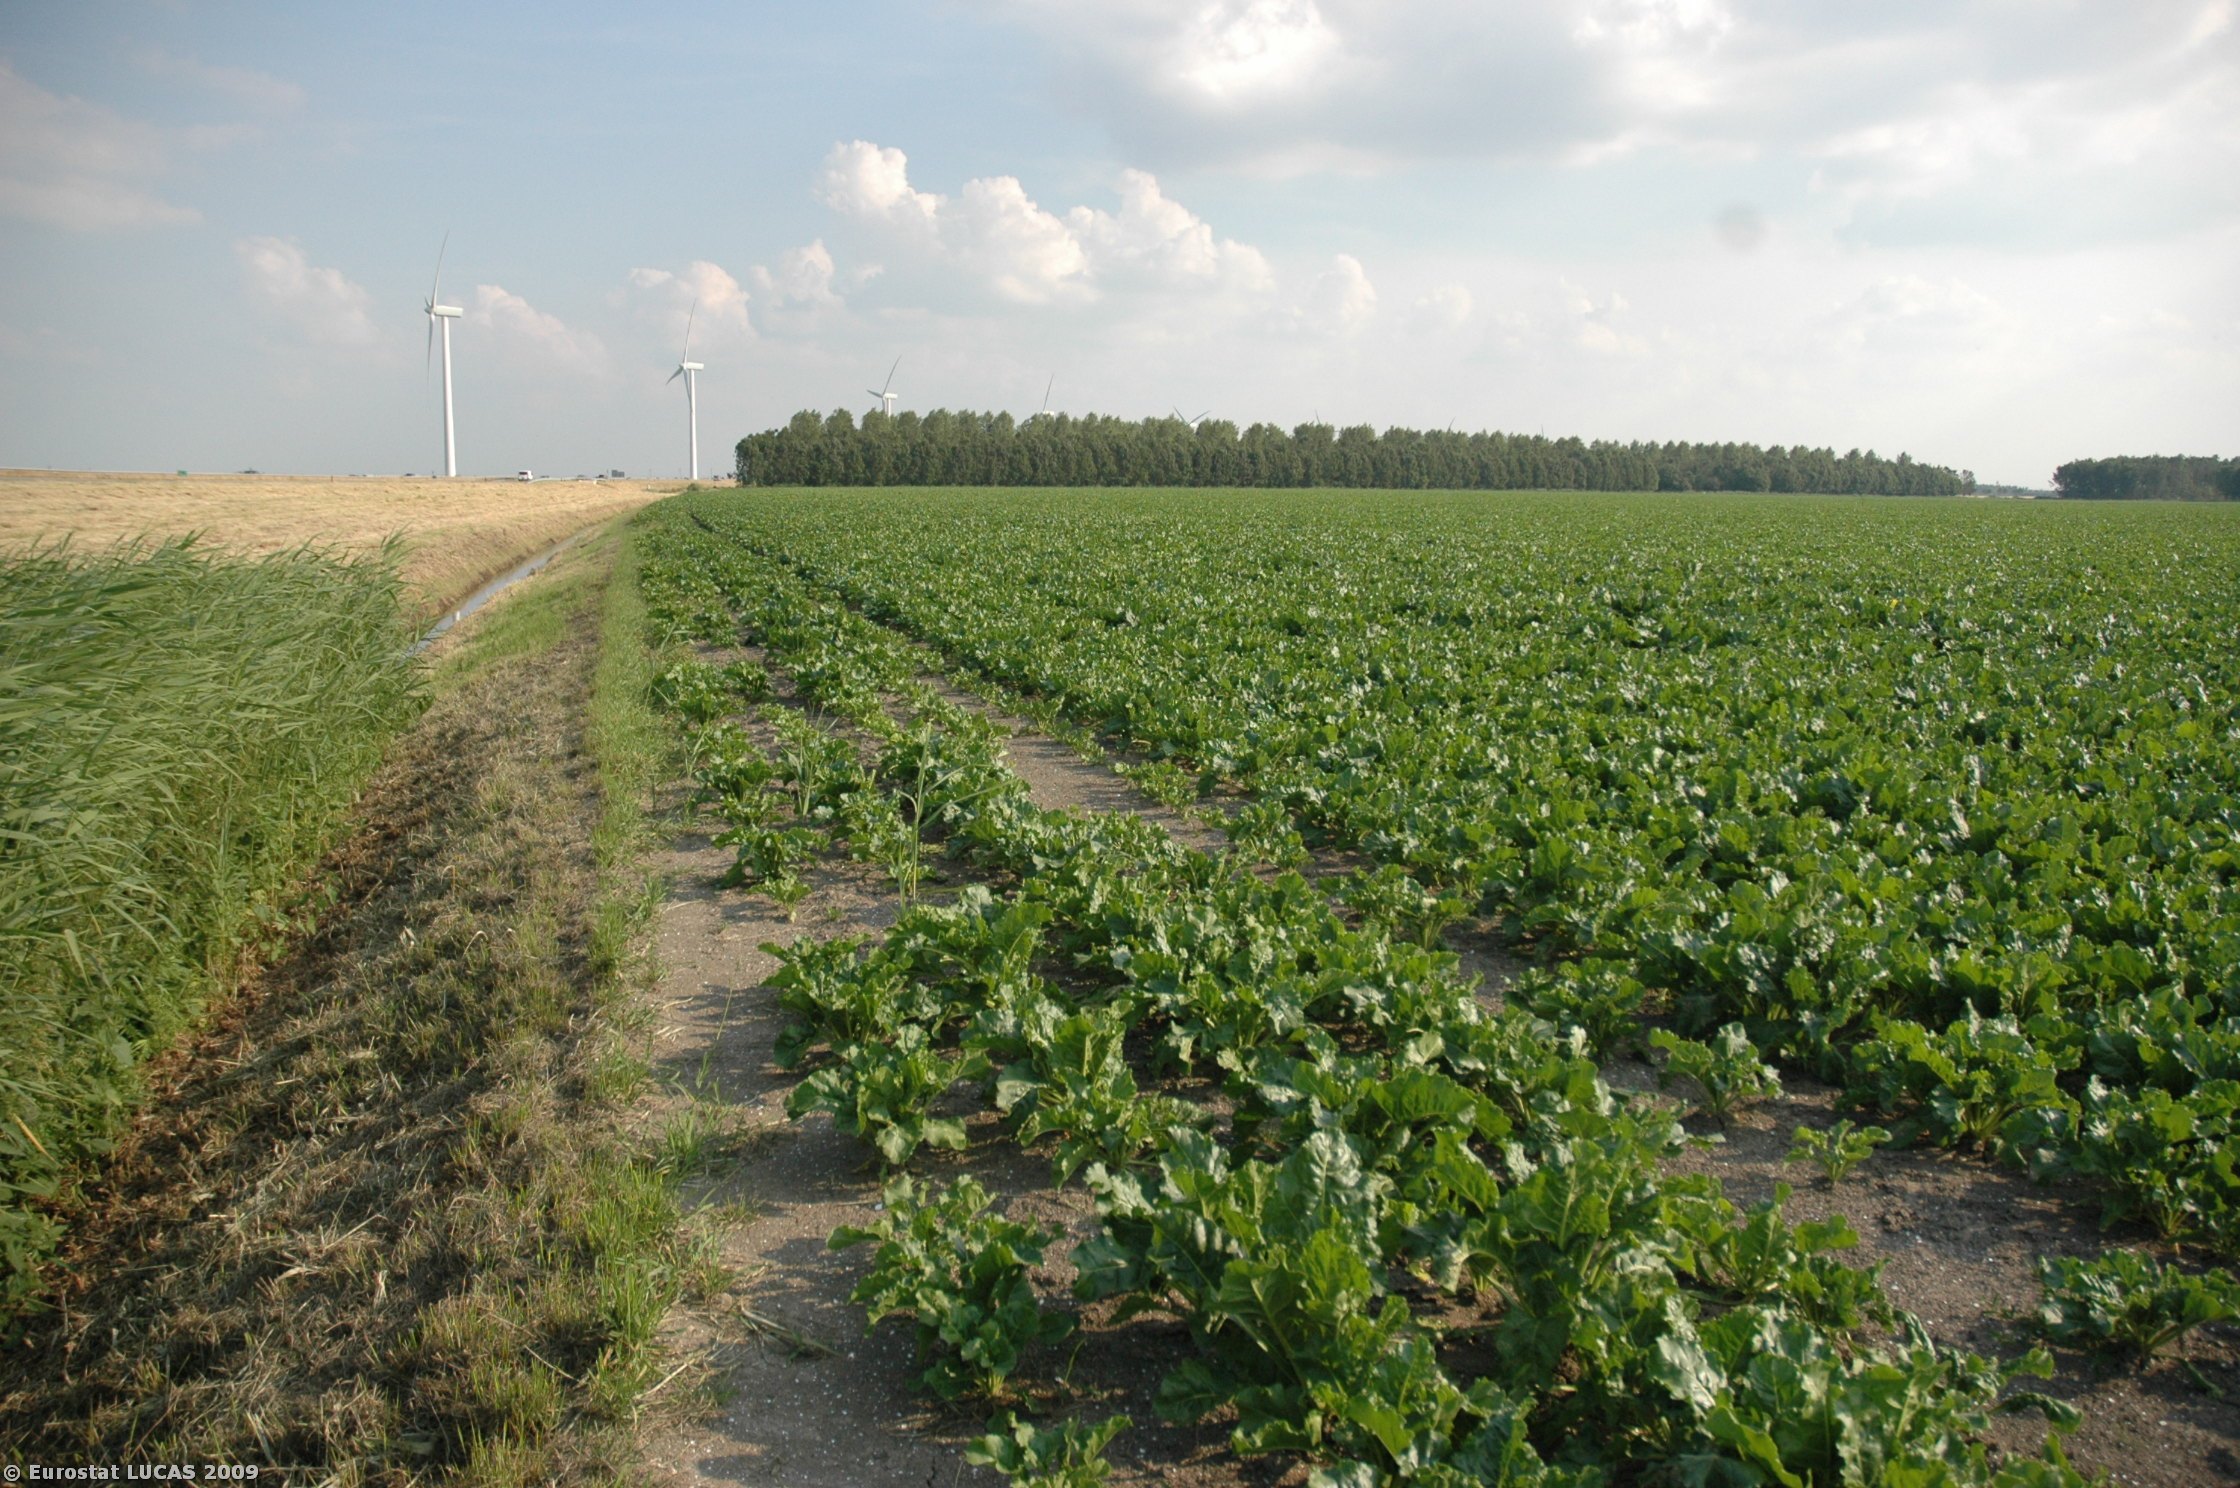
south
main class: Grassland
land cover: Grassland without tree/shrub cover
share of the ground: > 75 %
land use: Agriculture (excluding fallow land and kitchen gardens)
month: June
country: NL
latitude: 52.3403
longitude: 5.3453
